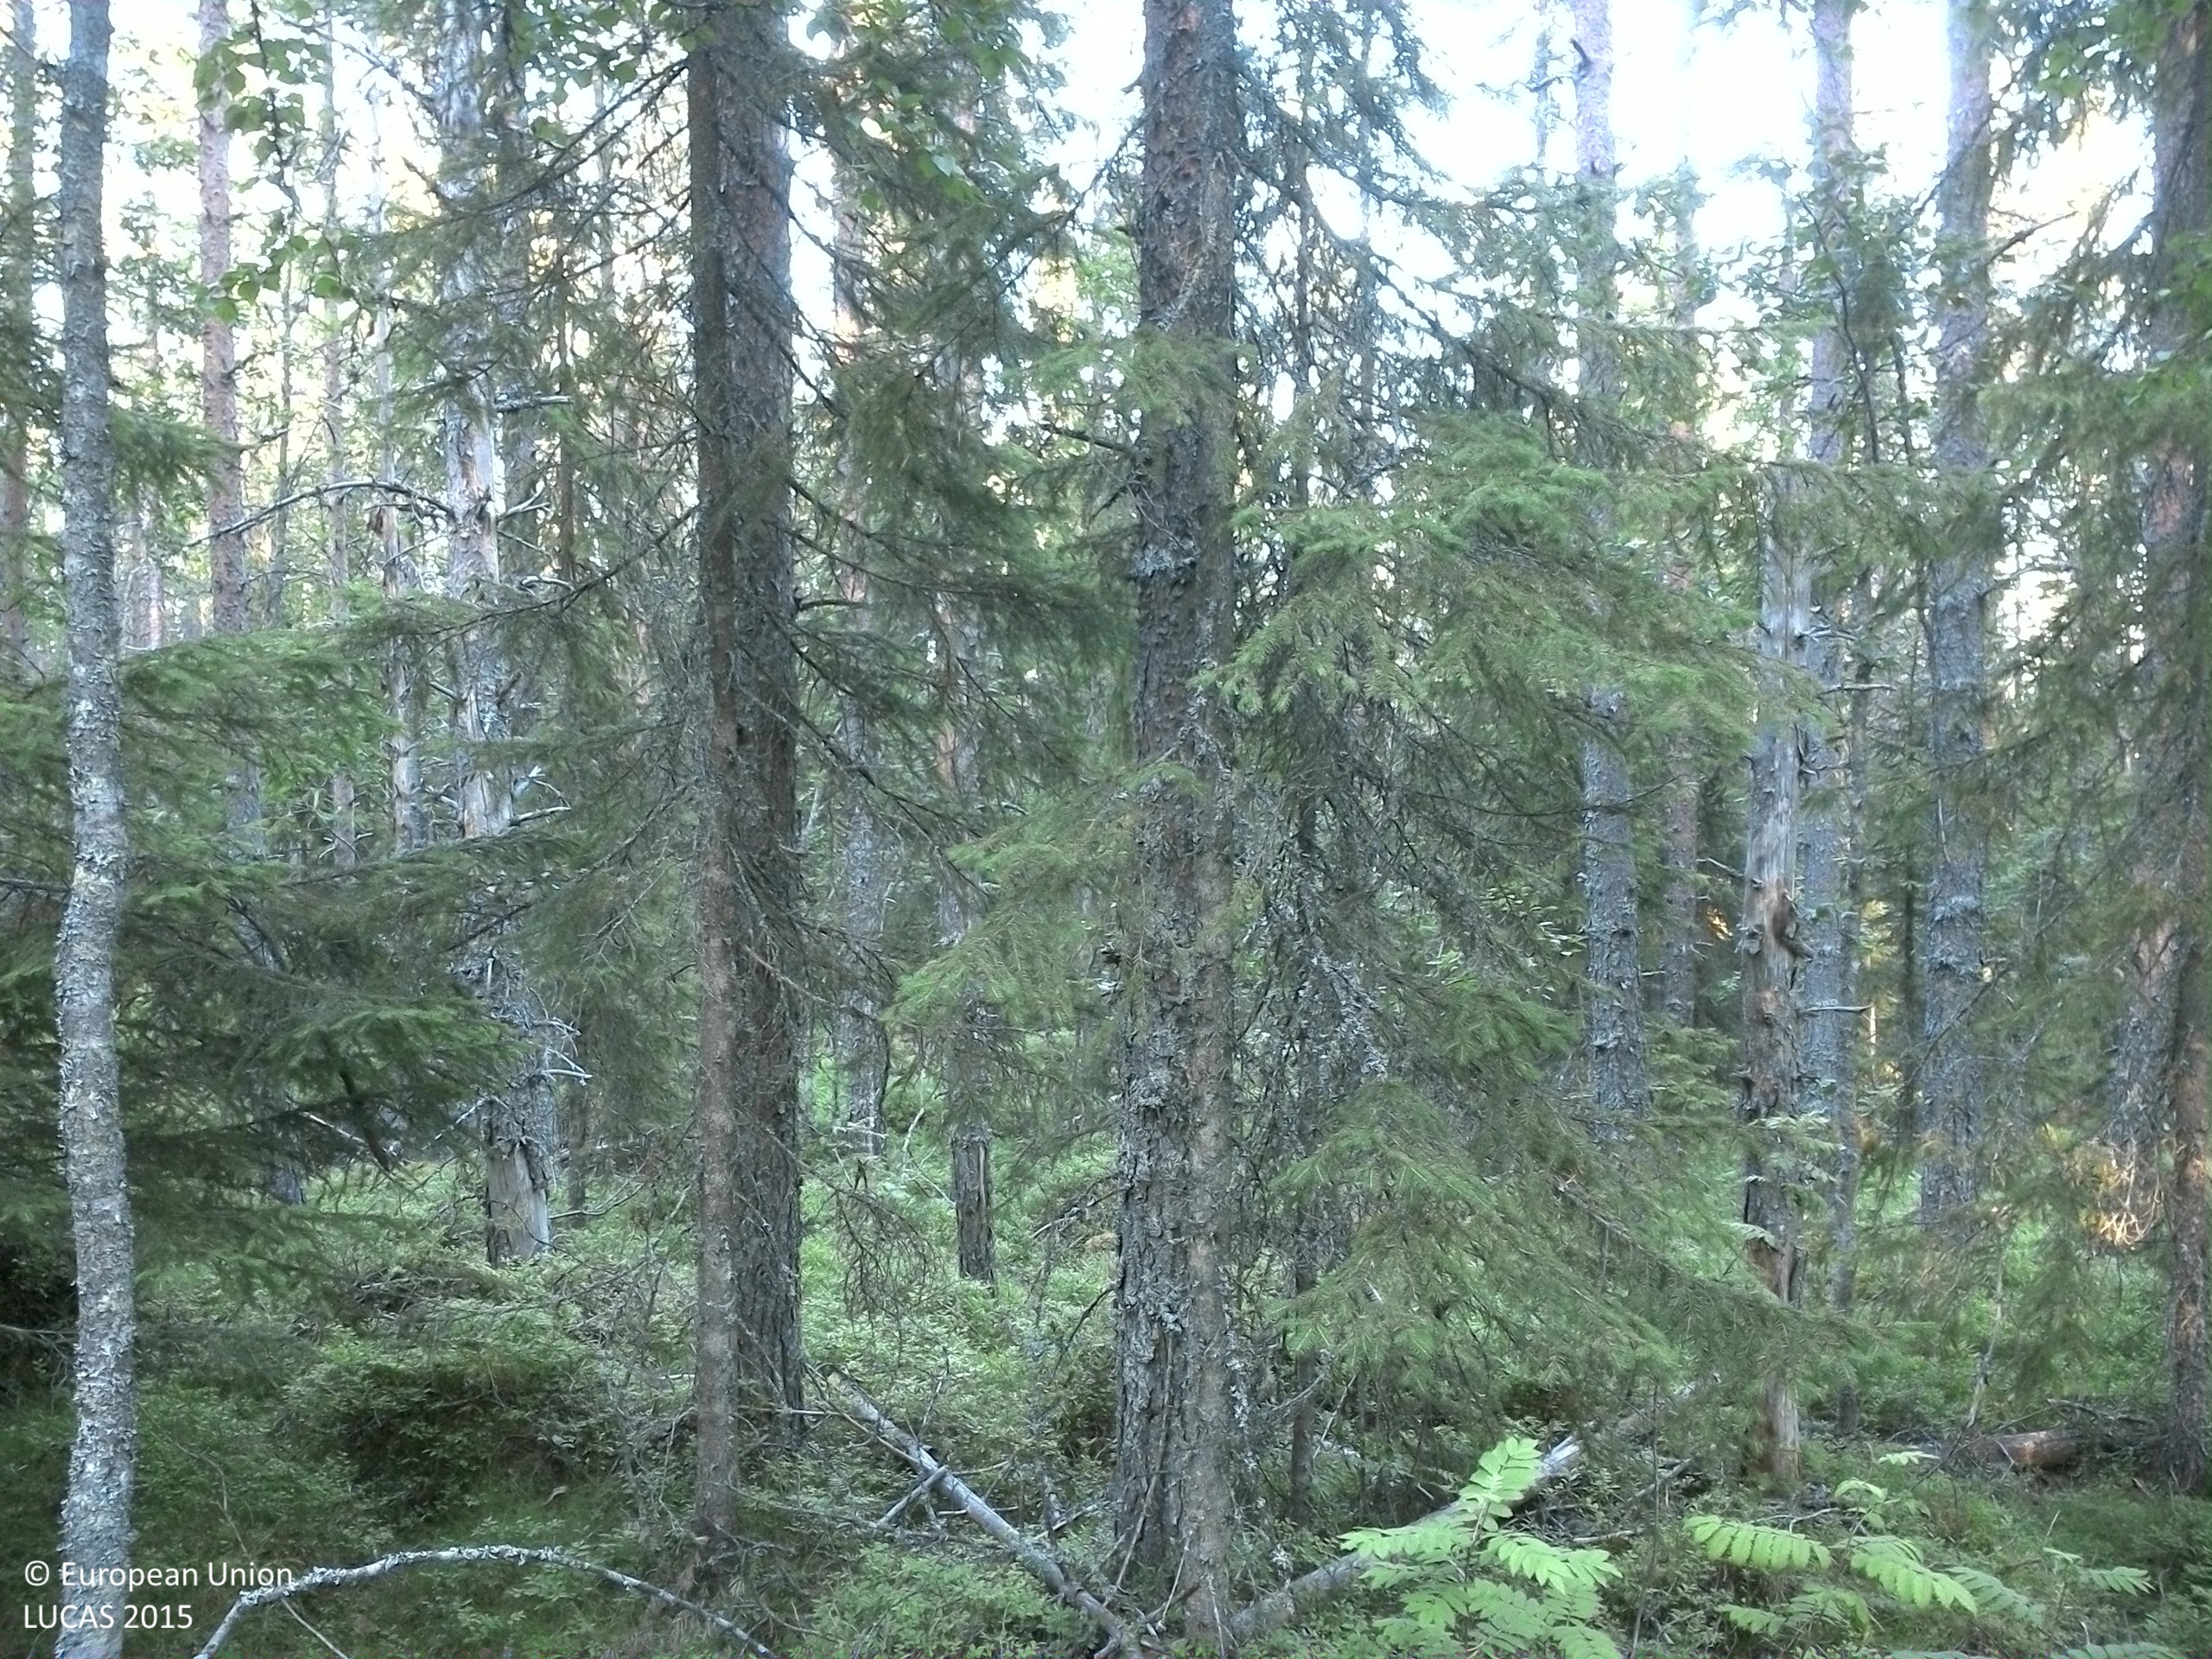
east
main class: Woodland
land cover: Pine dominated coniferous woodland
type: boreal forest
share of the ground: 50 - 75 %
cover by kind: coniferous forest trees 65 %, shrubs 30 %, broadleaved forest trees 5 %
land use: Forestry
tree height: > 5 m
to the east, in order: Pine dominated coniferous woodland; Spruce dominated mixed woodland; Ditches and canals; Spruce dominated mixed woodland; Ditches and canals; Spruce dominated mixed woodland
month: August
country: SE
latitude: 63.7992
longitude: 17.9506
